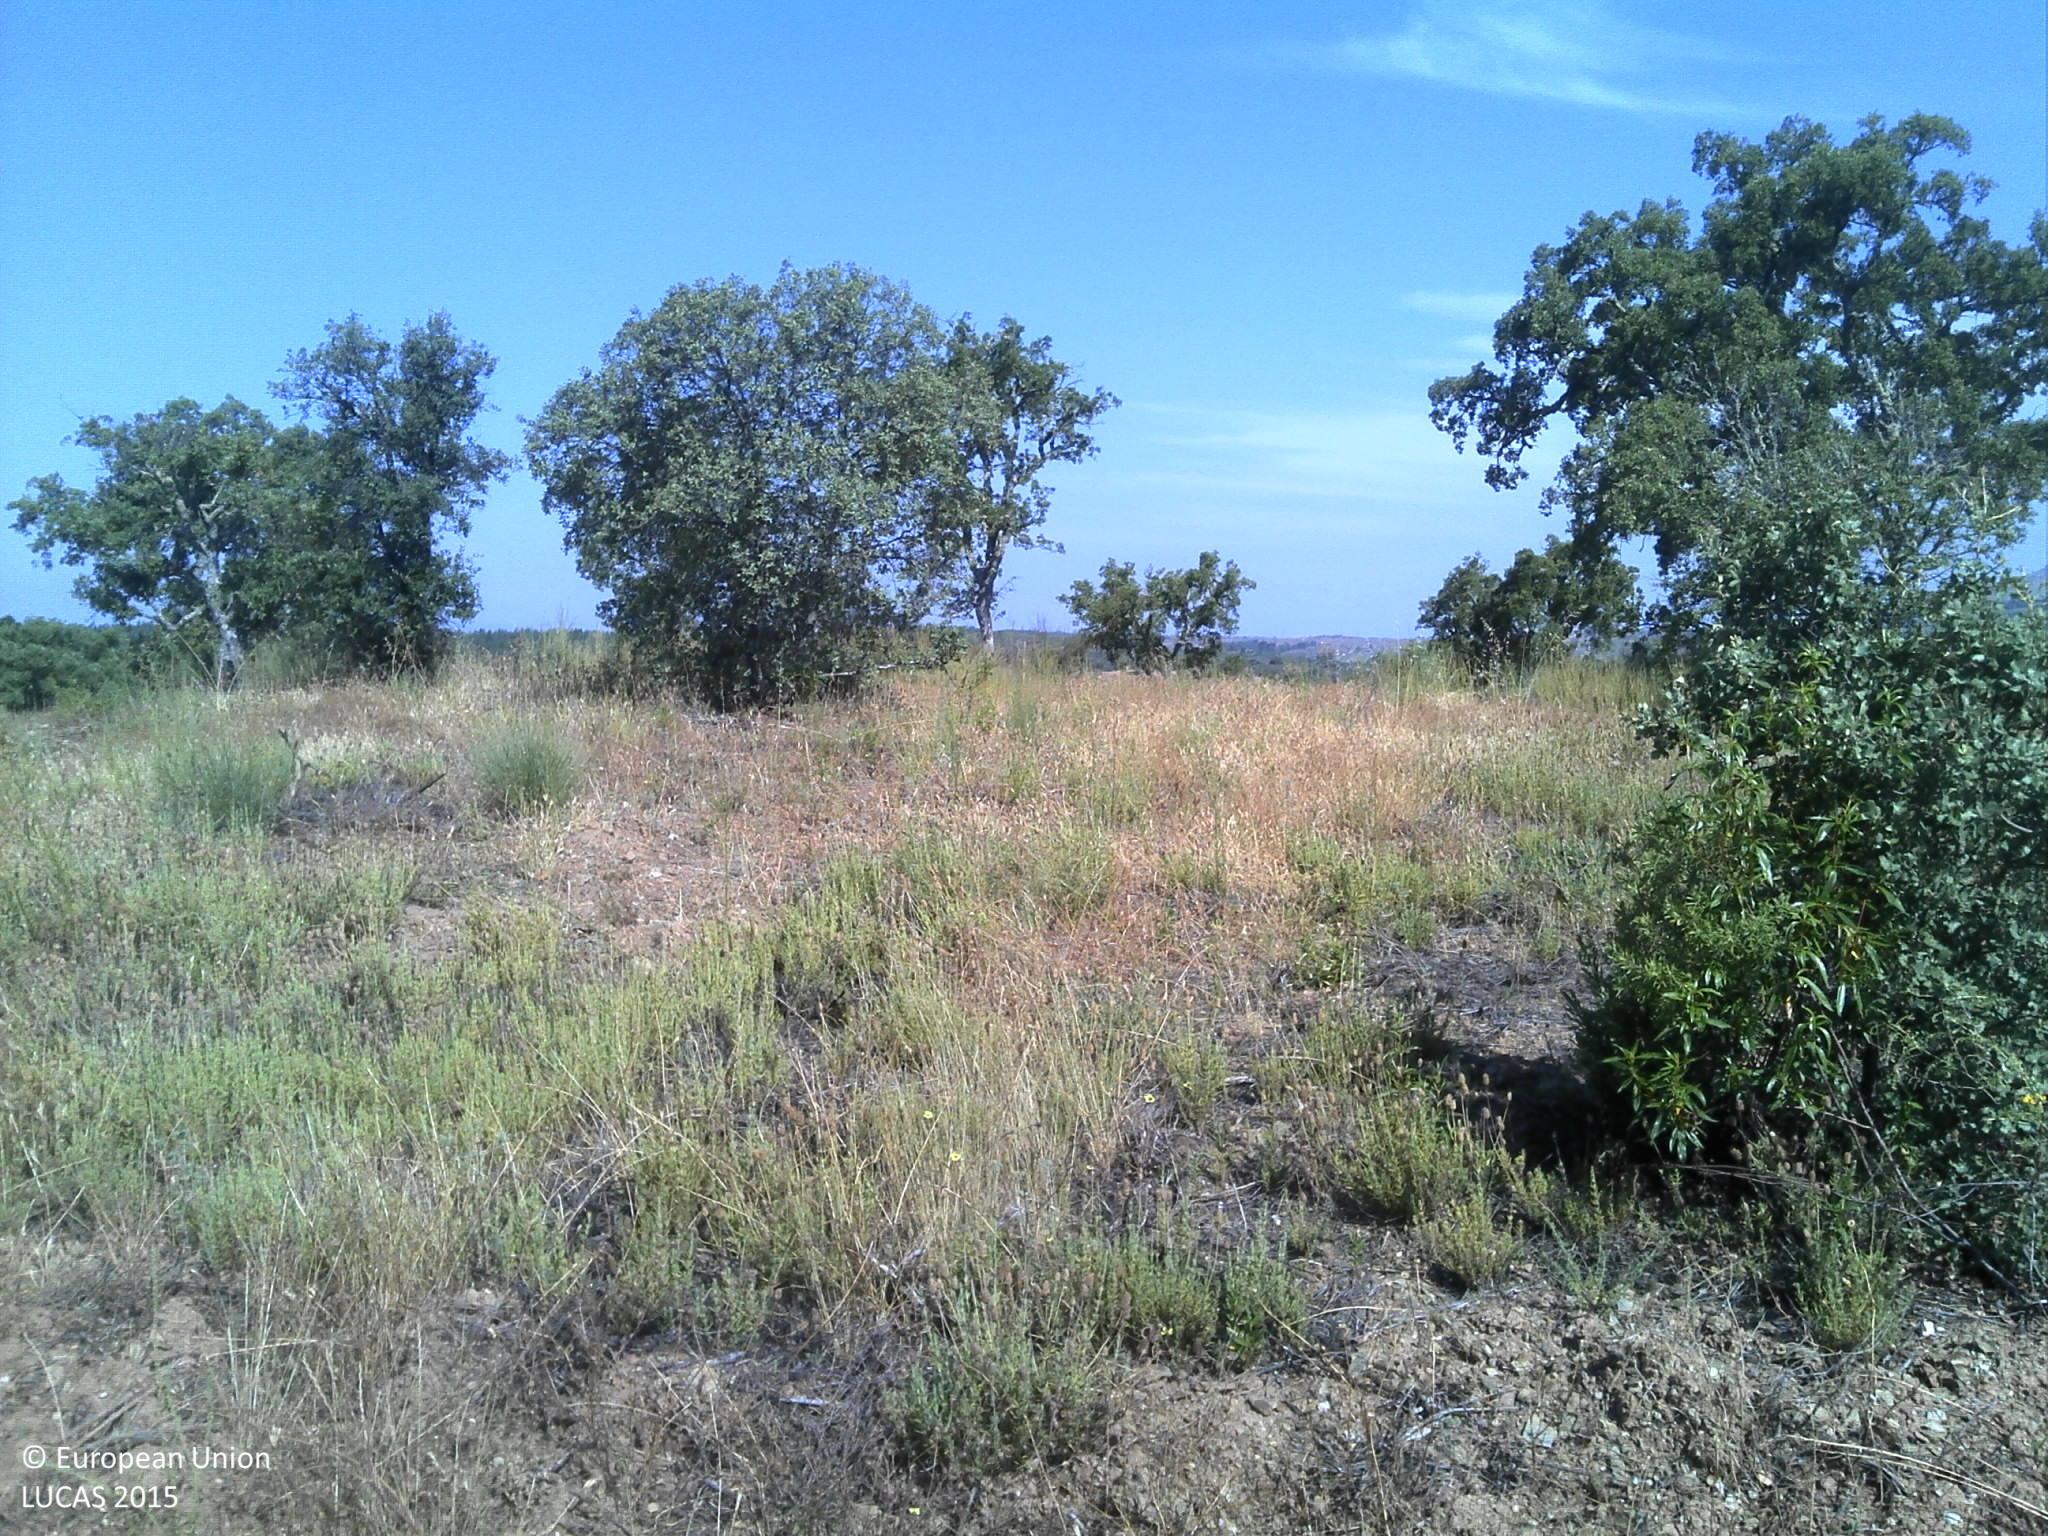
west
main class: Grassland
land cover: Spontaneously vegetated surfaces
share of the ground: 10 - 25 %
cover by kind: unconsolidated bare surface 85 %, herbaceous plants 15 %
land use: Agriculture (excluding fallow land and kitchen gardens)
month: June
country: PT
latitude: 39.9916
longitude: -7.0862
